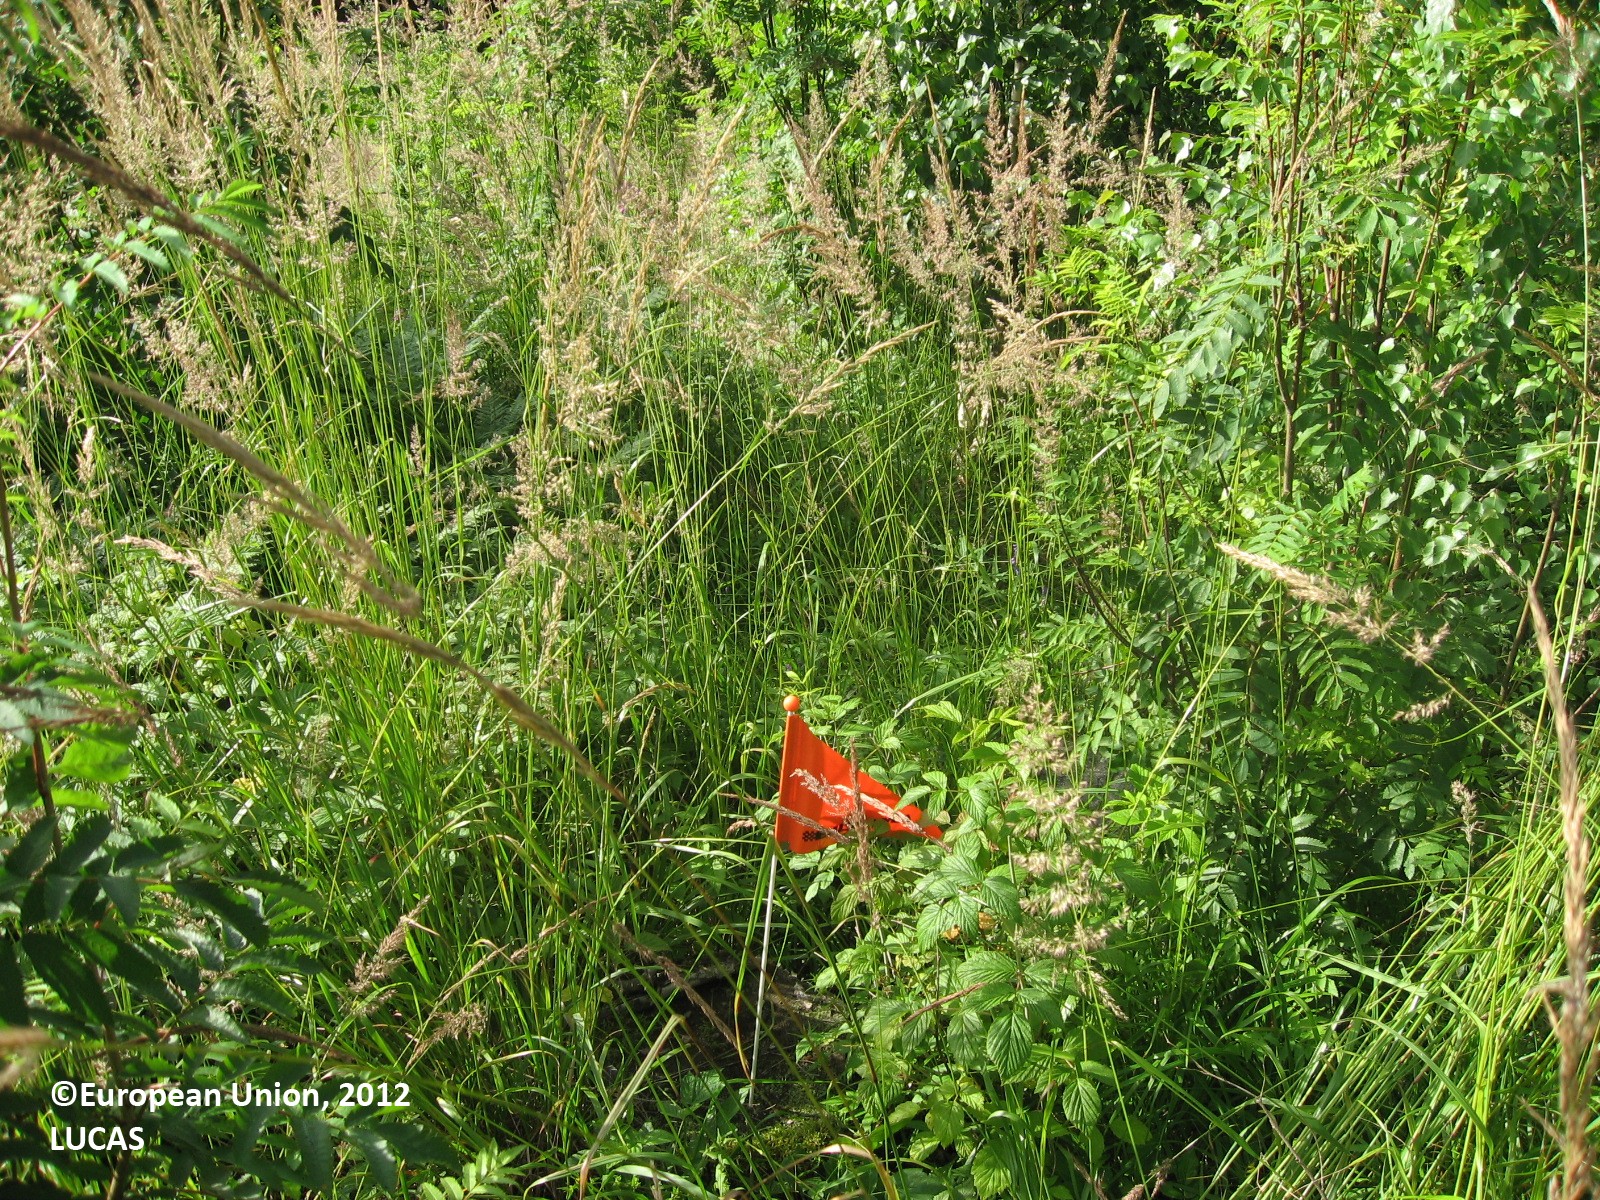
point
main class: Woodland
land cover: Broadleaved woodland
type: boreal forest
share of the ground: 10 - 25 %
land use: Forestry
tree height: < 5 m
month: July
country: FI
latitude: 61.2002
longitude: 25.7801
